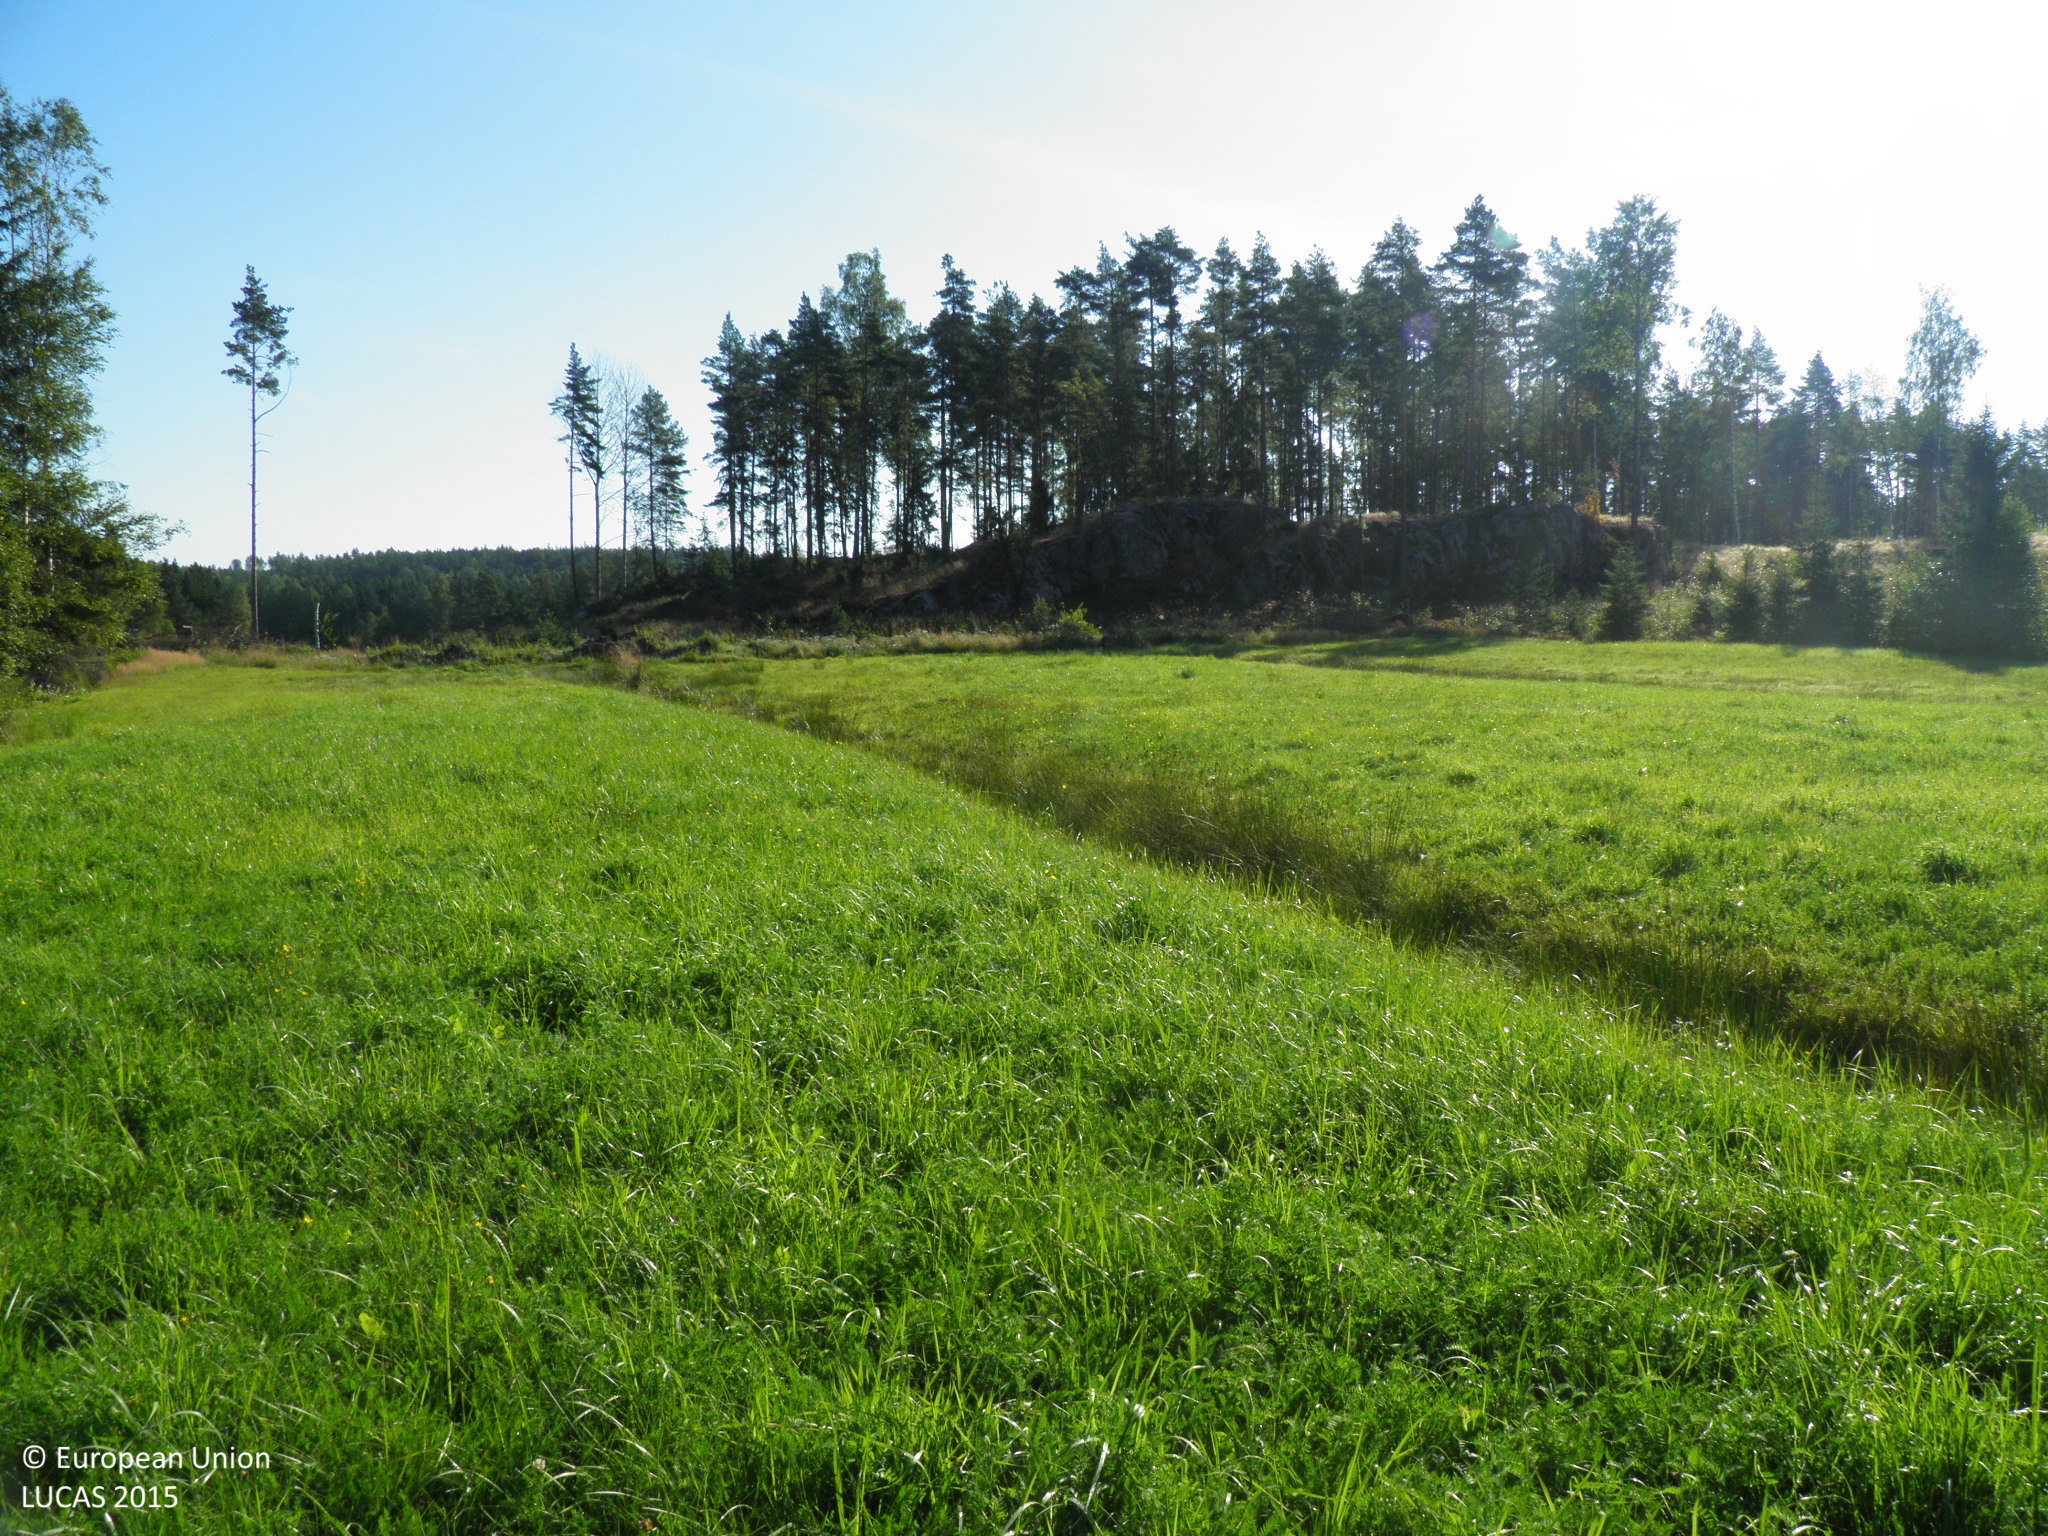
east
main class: Grassland
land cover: Grassland without tree/shrub cover
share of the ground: > 75 %
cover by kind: herbaceous plants 100 %
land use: Agriculture (excluding fallow land and kitchen gardens)
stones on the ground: < 10 %
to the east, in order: Grassland without tree/shrub cover; Ditches and canals; Grassland without tree/shrub cover; Ditches and canals; Grassland without tree/shrub cover; Ditches and canals; Shrubland without tree cover; Pine dominated coniferous woodland; Grassland with sparse tree/shrub cover
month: August
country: FI
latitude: 60.1932
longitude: 22.6451
